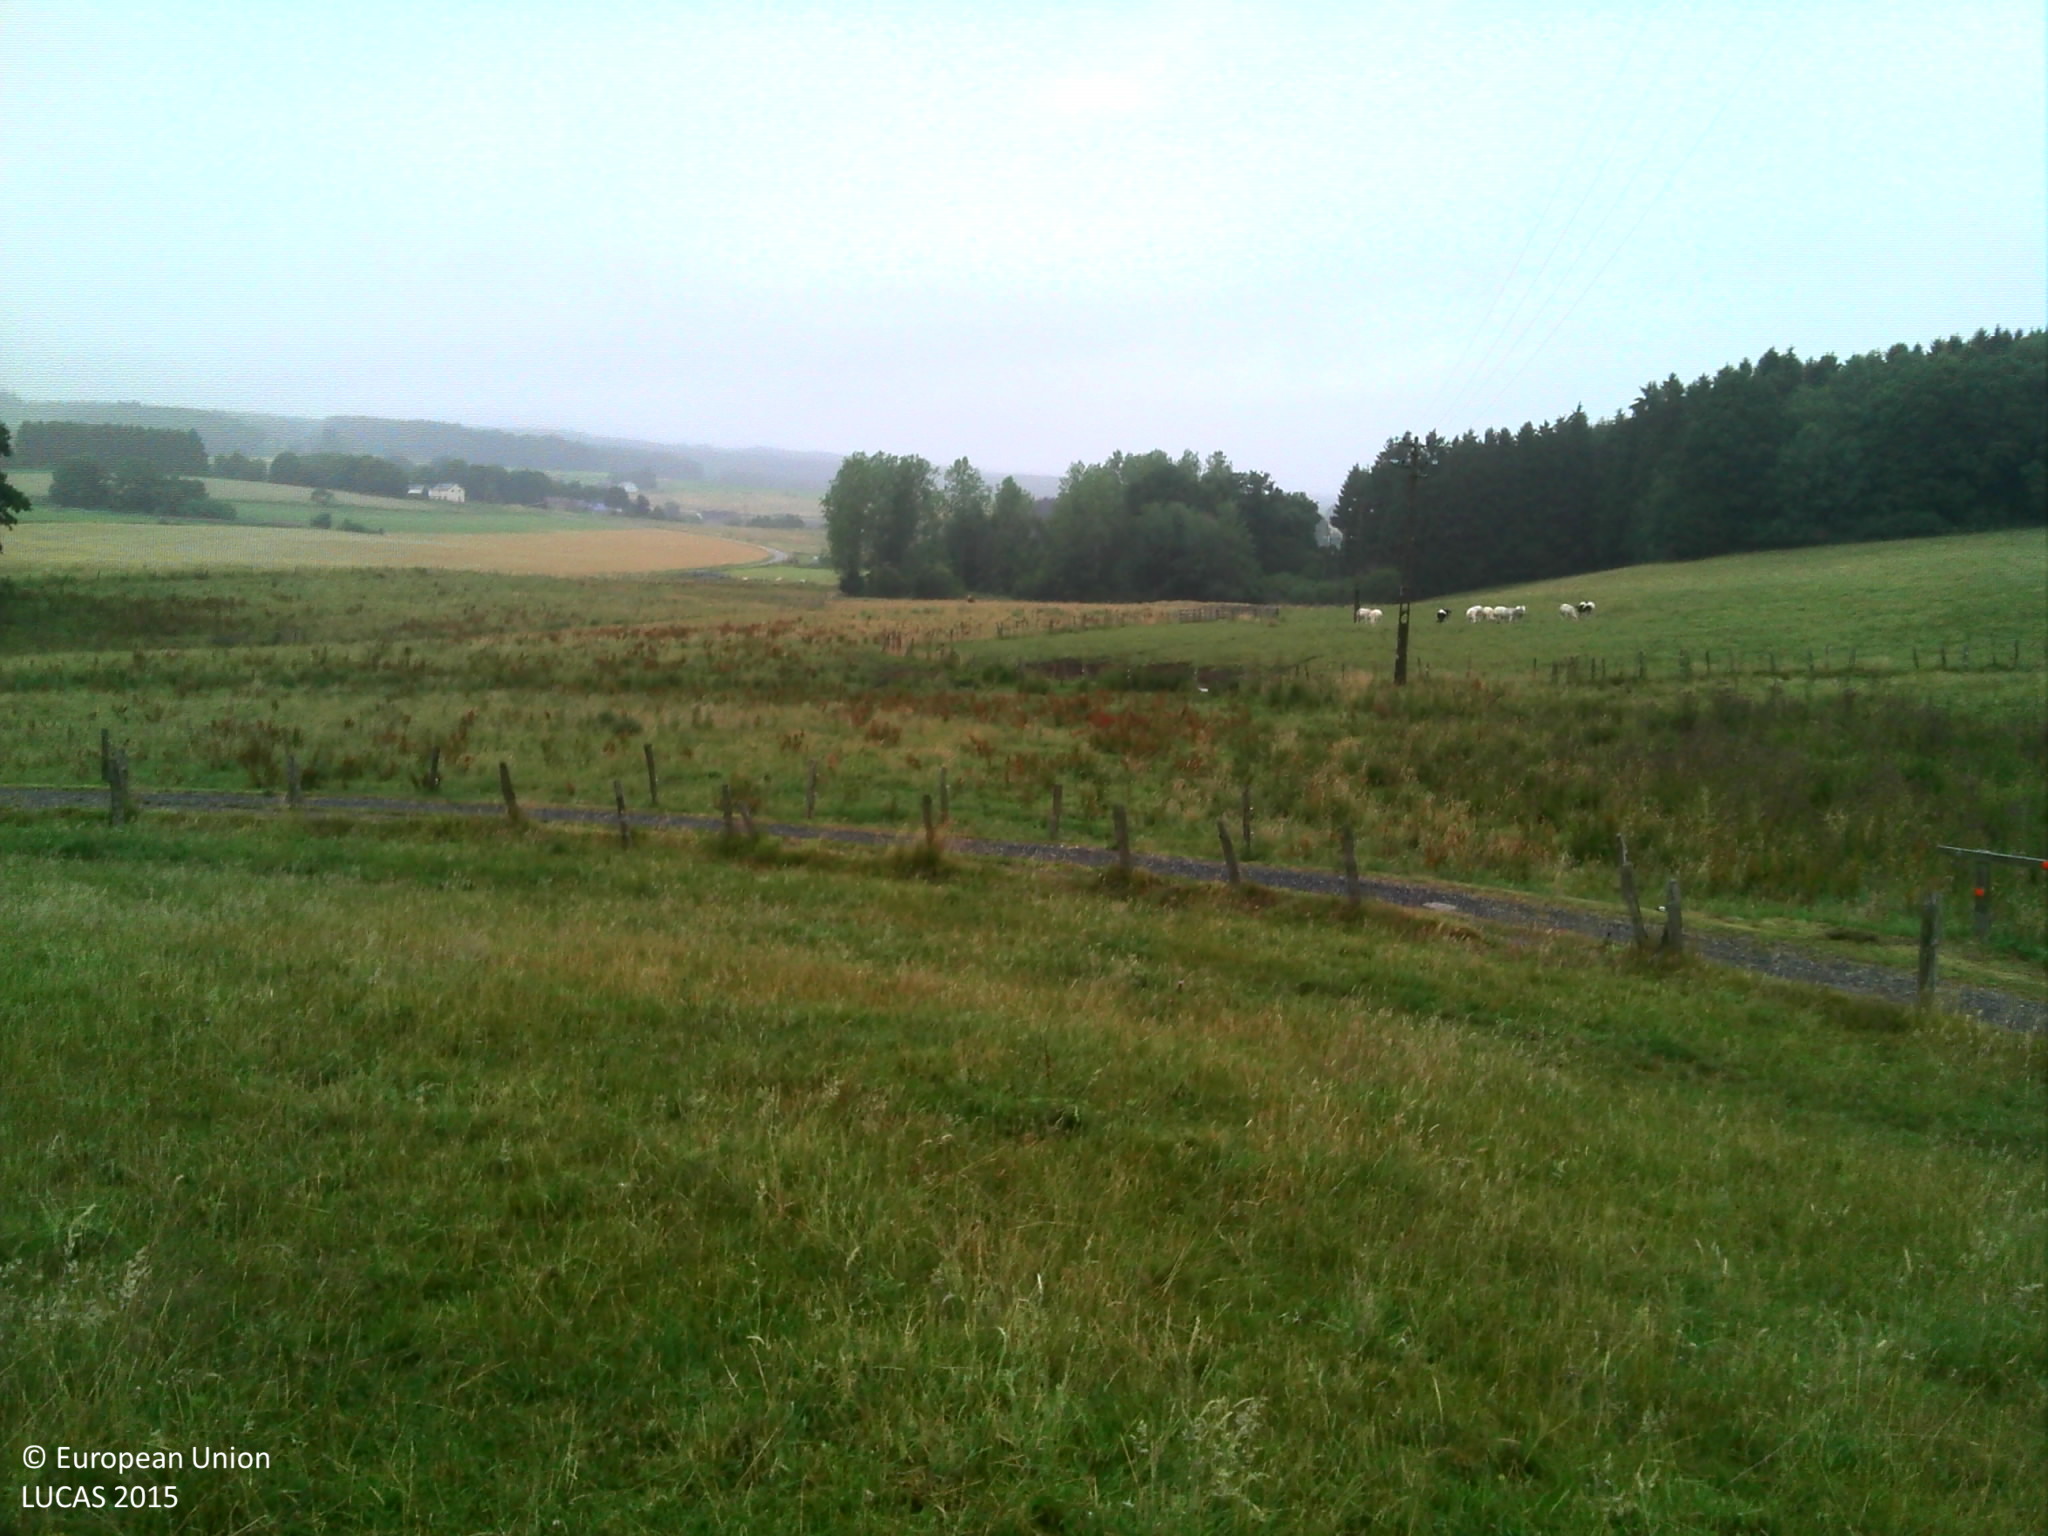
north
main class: Grassland
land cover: Grassland without tree/shrub cover
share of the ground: > 75 %
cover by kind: herbaceous plants 100 %
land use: Agriculture (excluding fallow land and kitchen gardens)
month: July
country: BE
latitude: 50.0453
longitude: 5.5997
